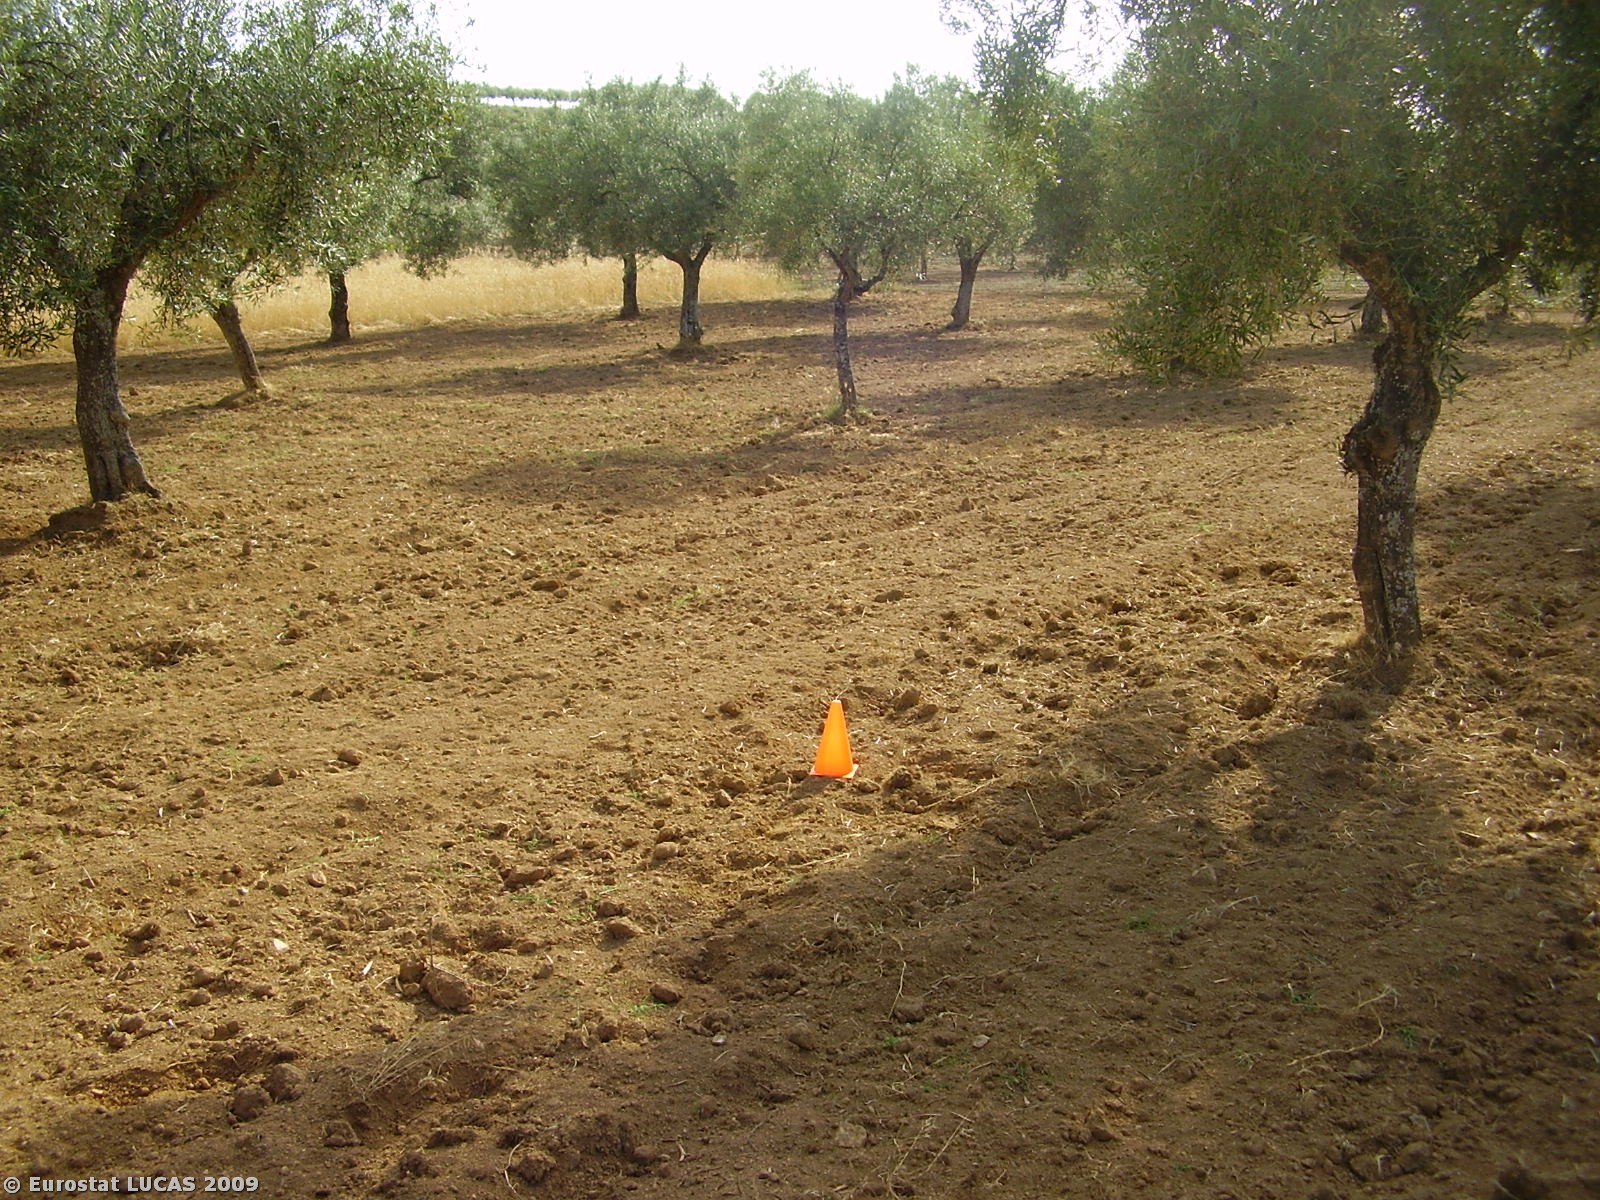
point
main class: Cropland
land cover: Olive groves
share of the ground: 25 - 50 %
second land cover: Bare land
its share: 50 - 75 %
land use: Agriculture (excluding fallow land and kitchen gardens)
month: June
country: PT
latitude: 41.4662
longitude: -6.7631
